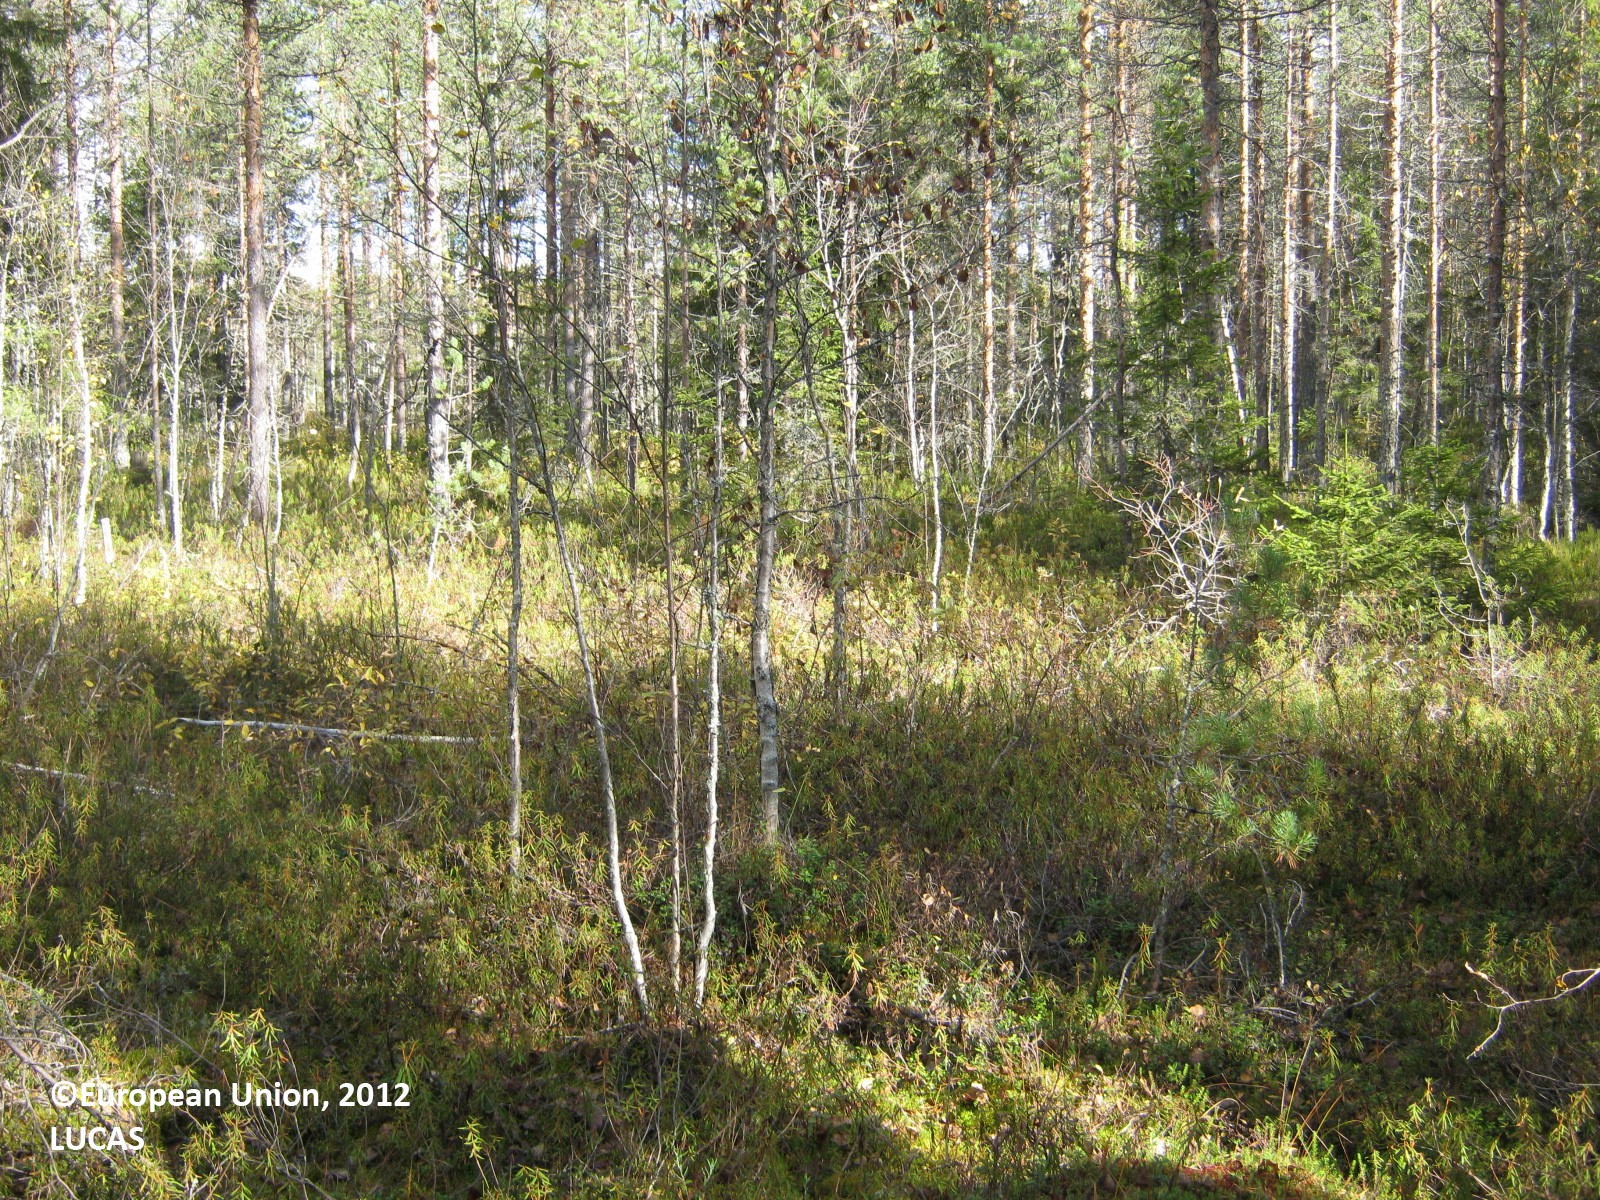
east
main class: Woodland
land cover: Pine dominated coniferous woodland
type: boreal forest
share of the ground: > 75 %
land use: Forestry
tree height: > 5 m
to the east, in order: Pine dominated coniferous woodland; Shrubland with sparse tree cover; Ditches and canals; Shrubland with sparse tree cover; Ditches and canals; Shrubland with sparse tree cover; Pine dominated mixed woodland
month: September
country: FI
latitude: 63.4338
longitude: 25.9662
